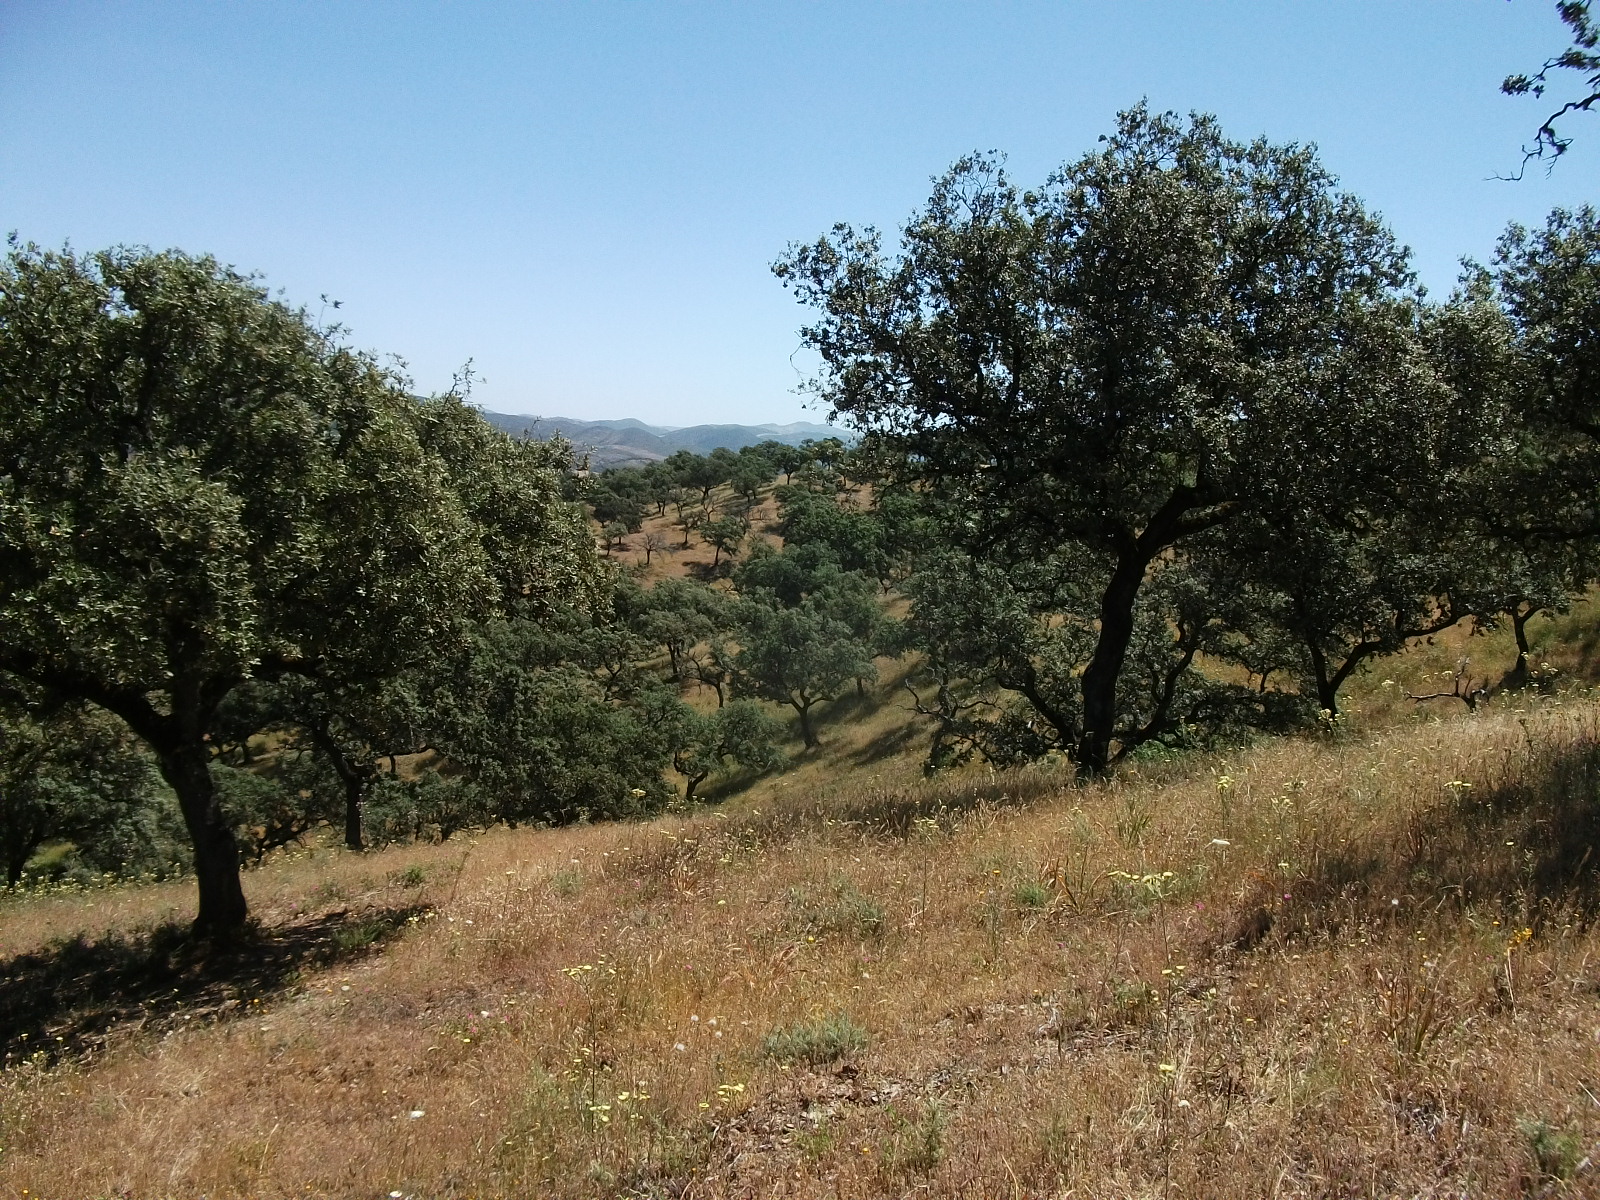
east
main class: Woodland
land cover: Broadleaved woodland
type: broadleaved evergreen forest
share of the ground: 25 - 50 %
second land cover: Spontaneously vegetated surfaces
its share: 50 - 75 %
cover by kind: herbaceous plants 60 %, broadleaved forest trees 40 %
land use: Forestry
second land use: Agriculture (excluding fallow land and kitchen gardens)
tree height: > 5 m
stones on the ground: 25 - 50 %
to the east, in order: Broadleaved woodland; Spontaneously vegetated surfaces; Fences; Broadleaved woodland
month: May
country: ES
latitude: 37.9562
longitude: -6.6050
